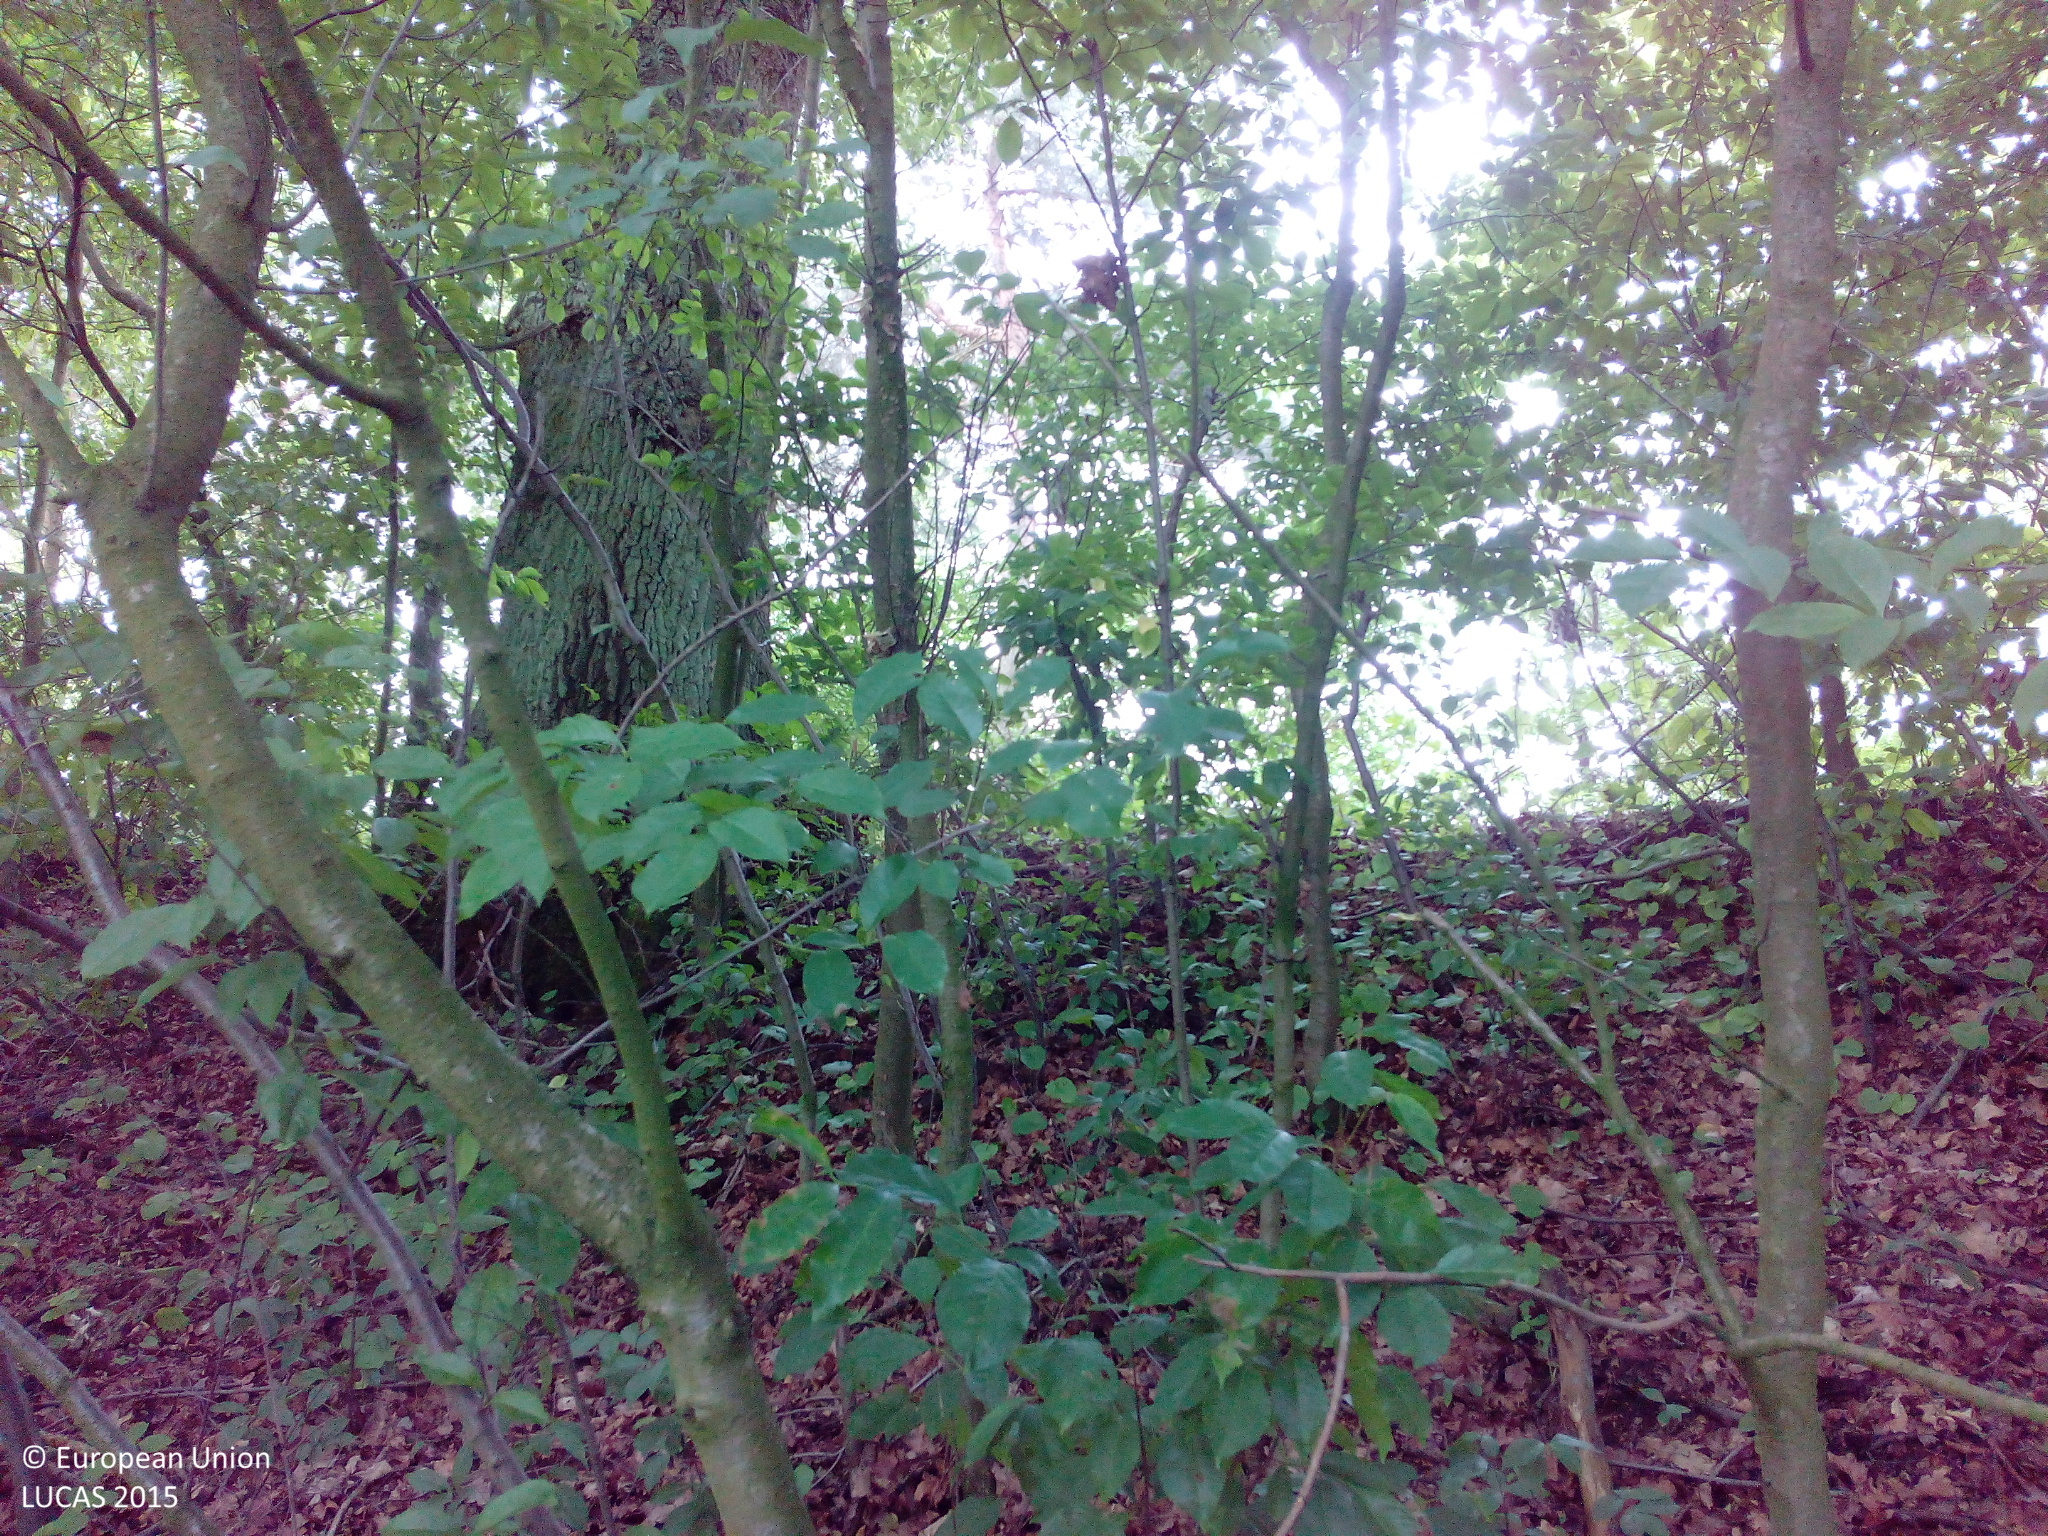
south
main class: Woodland
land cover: Broadleaved woodland
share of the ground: > 75 %
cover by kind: broadleaved forest trees 95 %, unconsolidated bare surface 5 %
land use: Forestry
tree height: > 5 m
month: July
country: DE
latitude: 53.0675
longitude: 11.6261
